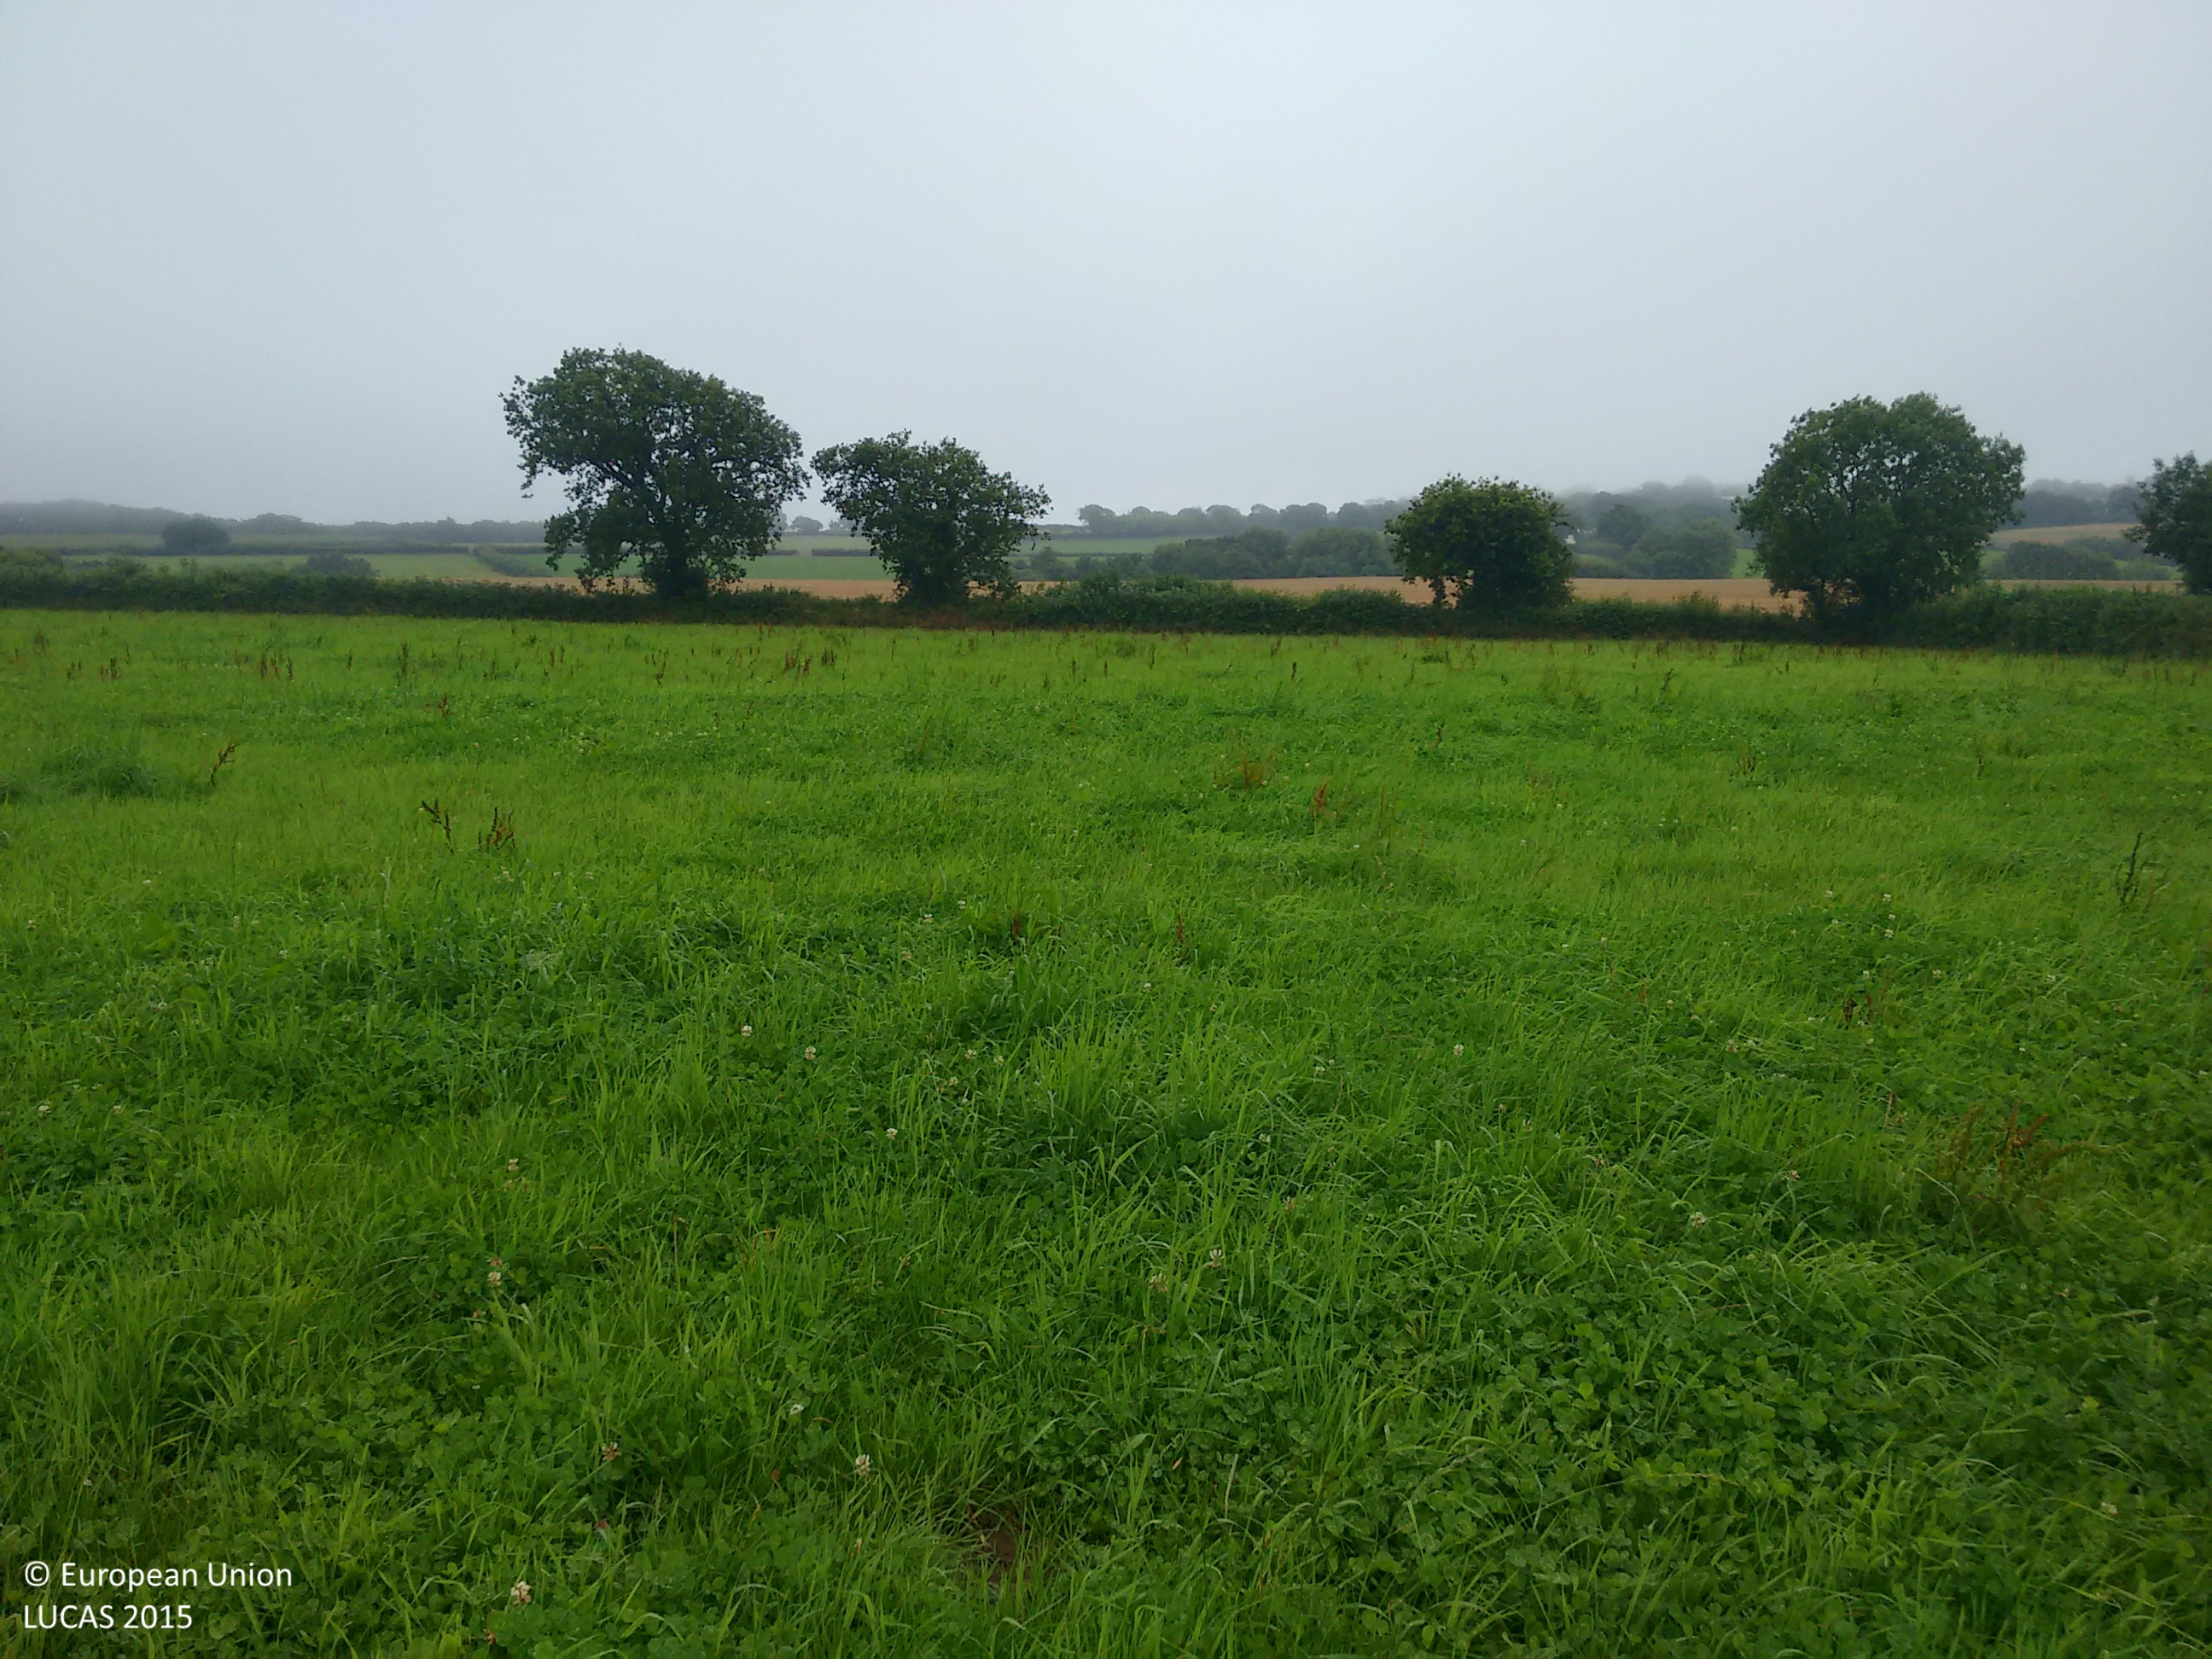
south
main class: Grassland
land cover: Grassland without tree/shrub cover
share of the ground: > 75 %
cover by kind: herbaceous plants 100 %
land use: Agriculture (excluding fallow land and kitchen gardens)
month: August
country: GB
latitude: 50.8858
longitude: -3.6914
